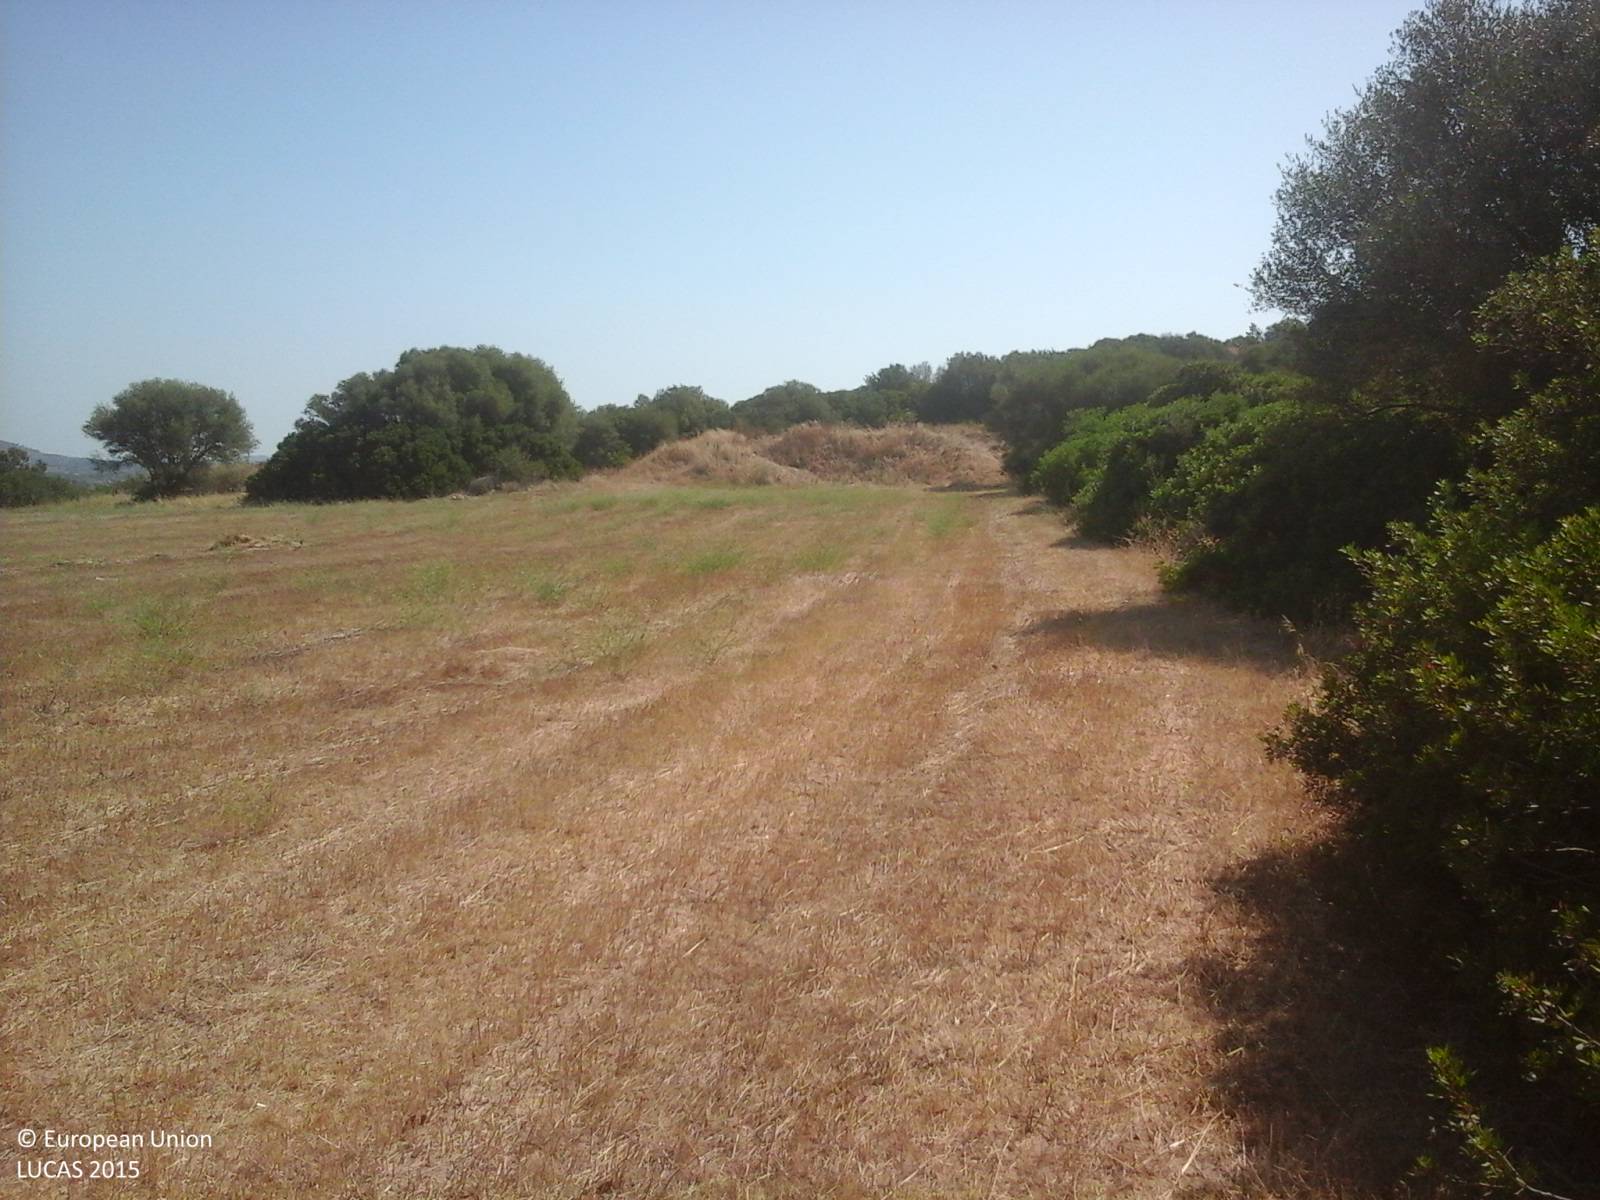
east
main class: Cropland
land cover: Temporary grasslands
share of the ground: > 75 %
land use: Agriculture (excluding fallow land and kitchen gardens)
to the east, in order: Temporary grasslands; Broadleaved woodland; Shrubland with sparse tree cover; Broadleaved woodland; Grassland with sparse tree/shrub cover; Broadleaved woodland; Grassland with sparse tree/shrub cover; Sand; Abandoned hedges; Grassland without tree/shrub cover
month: July
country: IT
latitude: 40.9172
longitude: 9.4446
